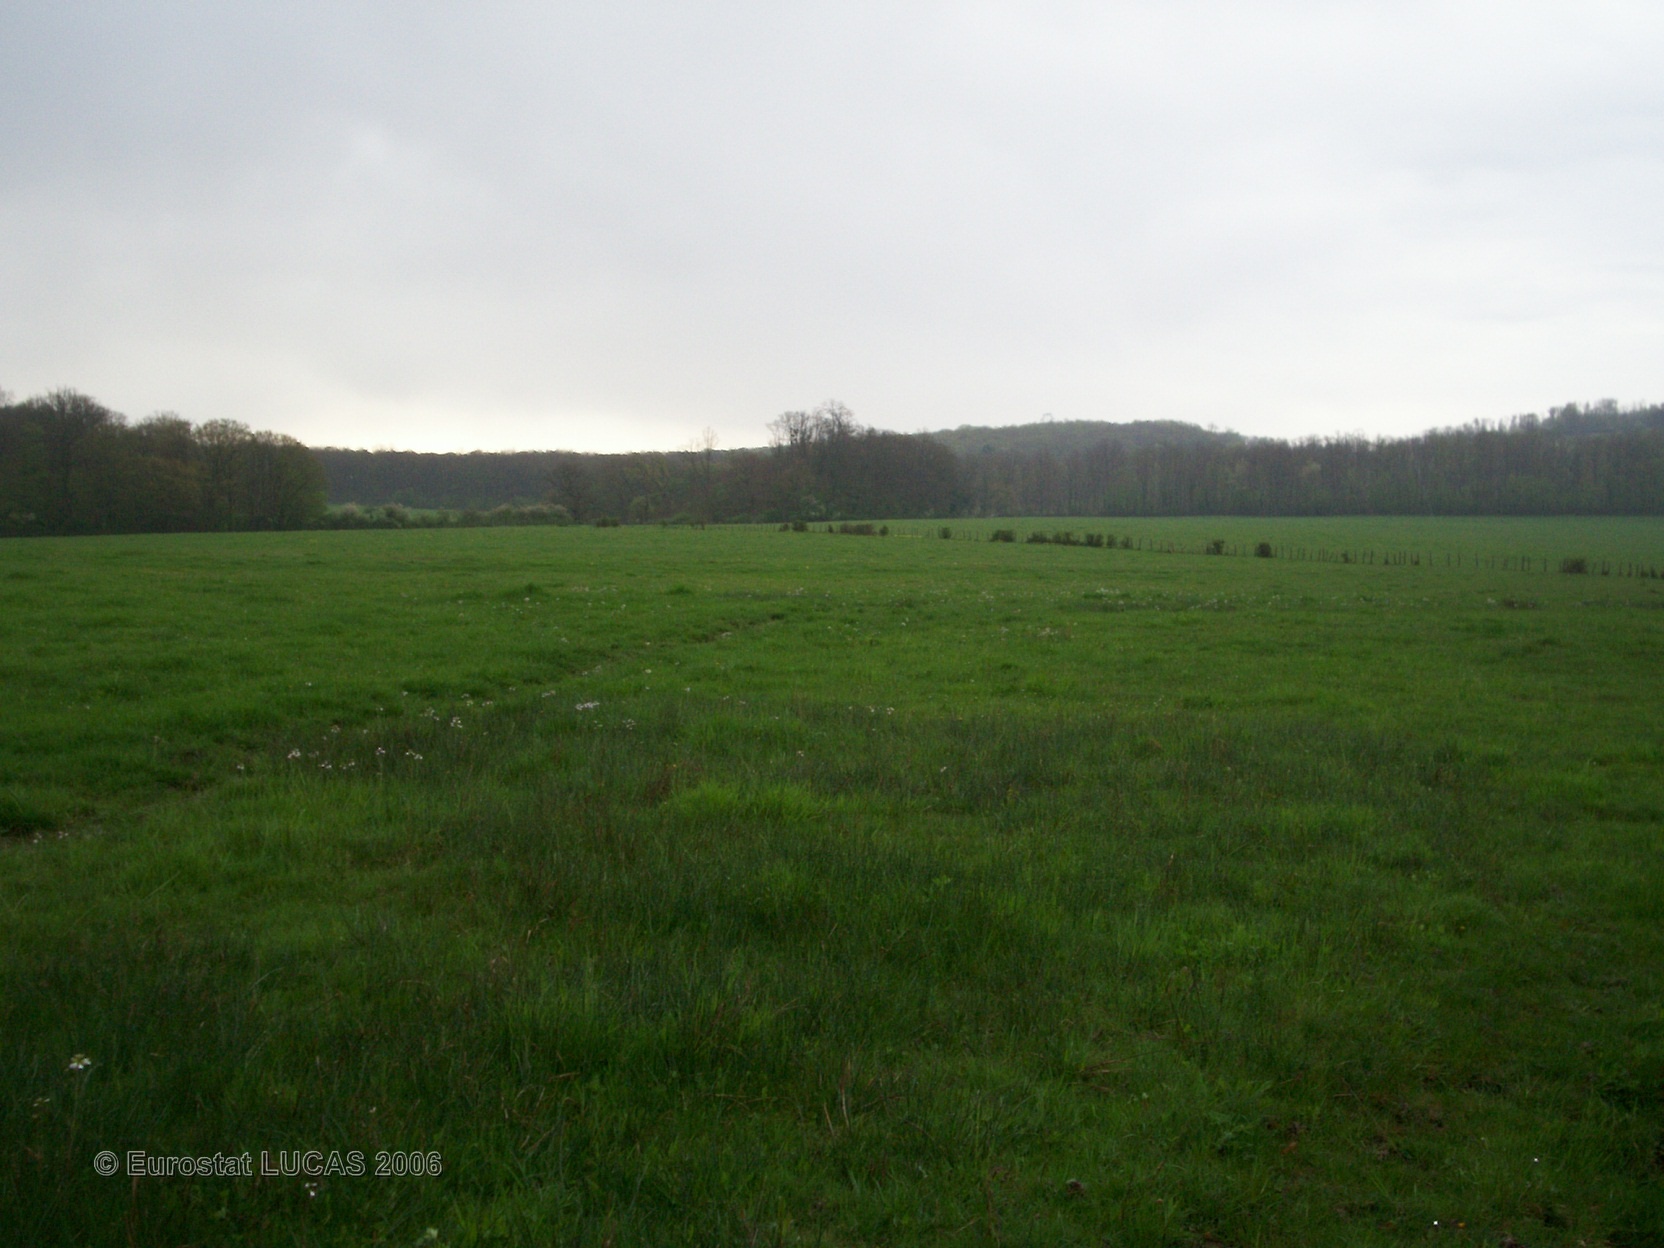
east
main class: Grassland
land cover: Grassland without tree/shrub cover
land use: Agriculture (excluding fallow land and kitchen gardens)
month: April
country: FR
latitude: 46.8291
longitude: 4.6128
